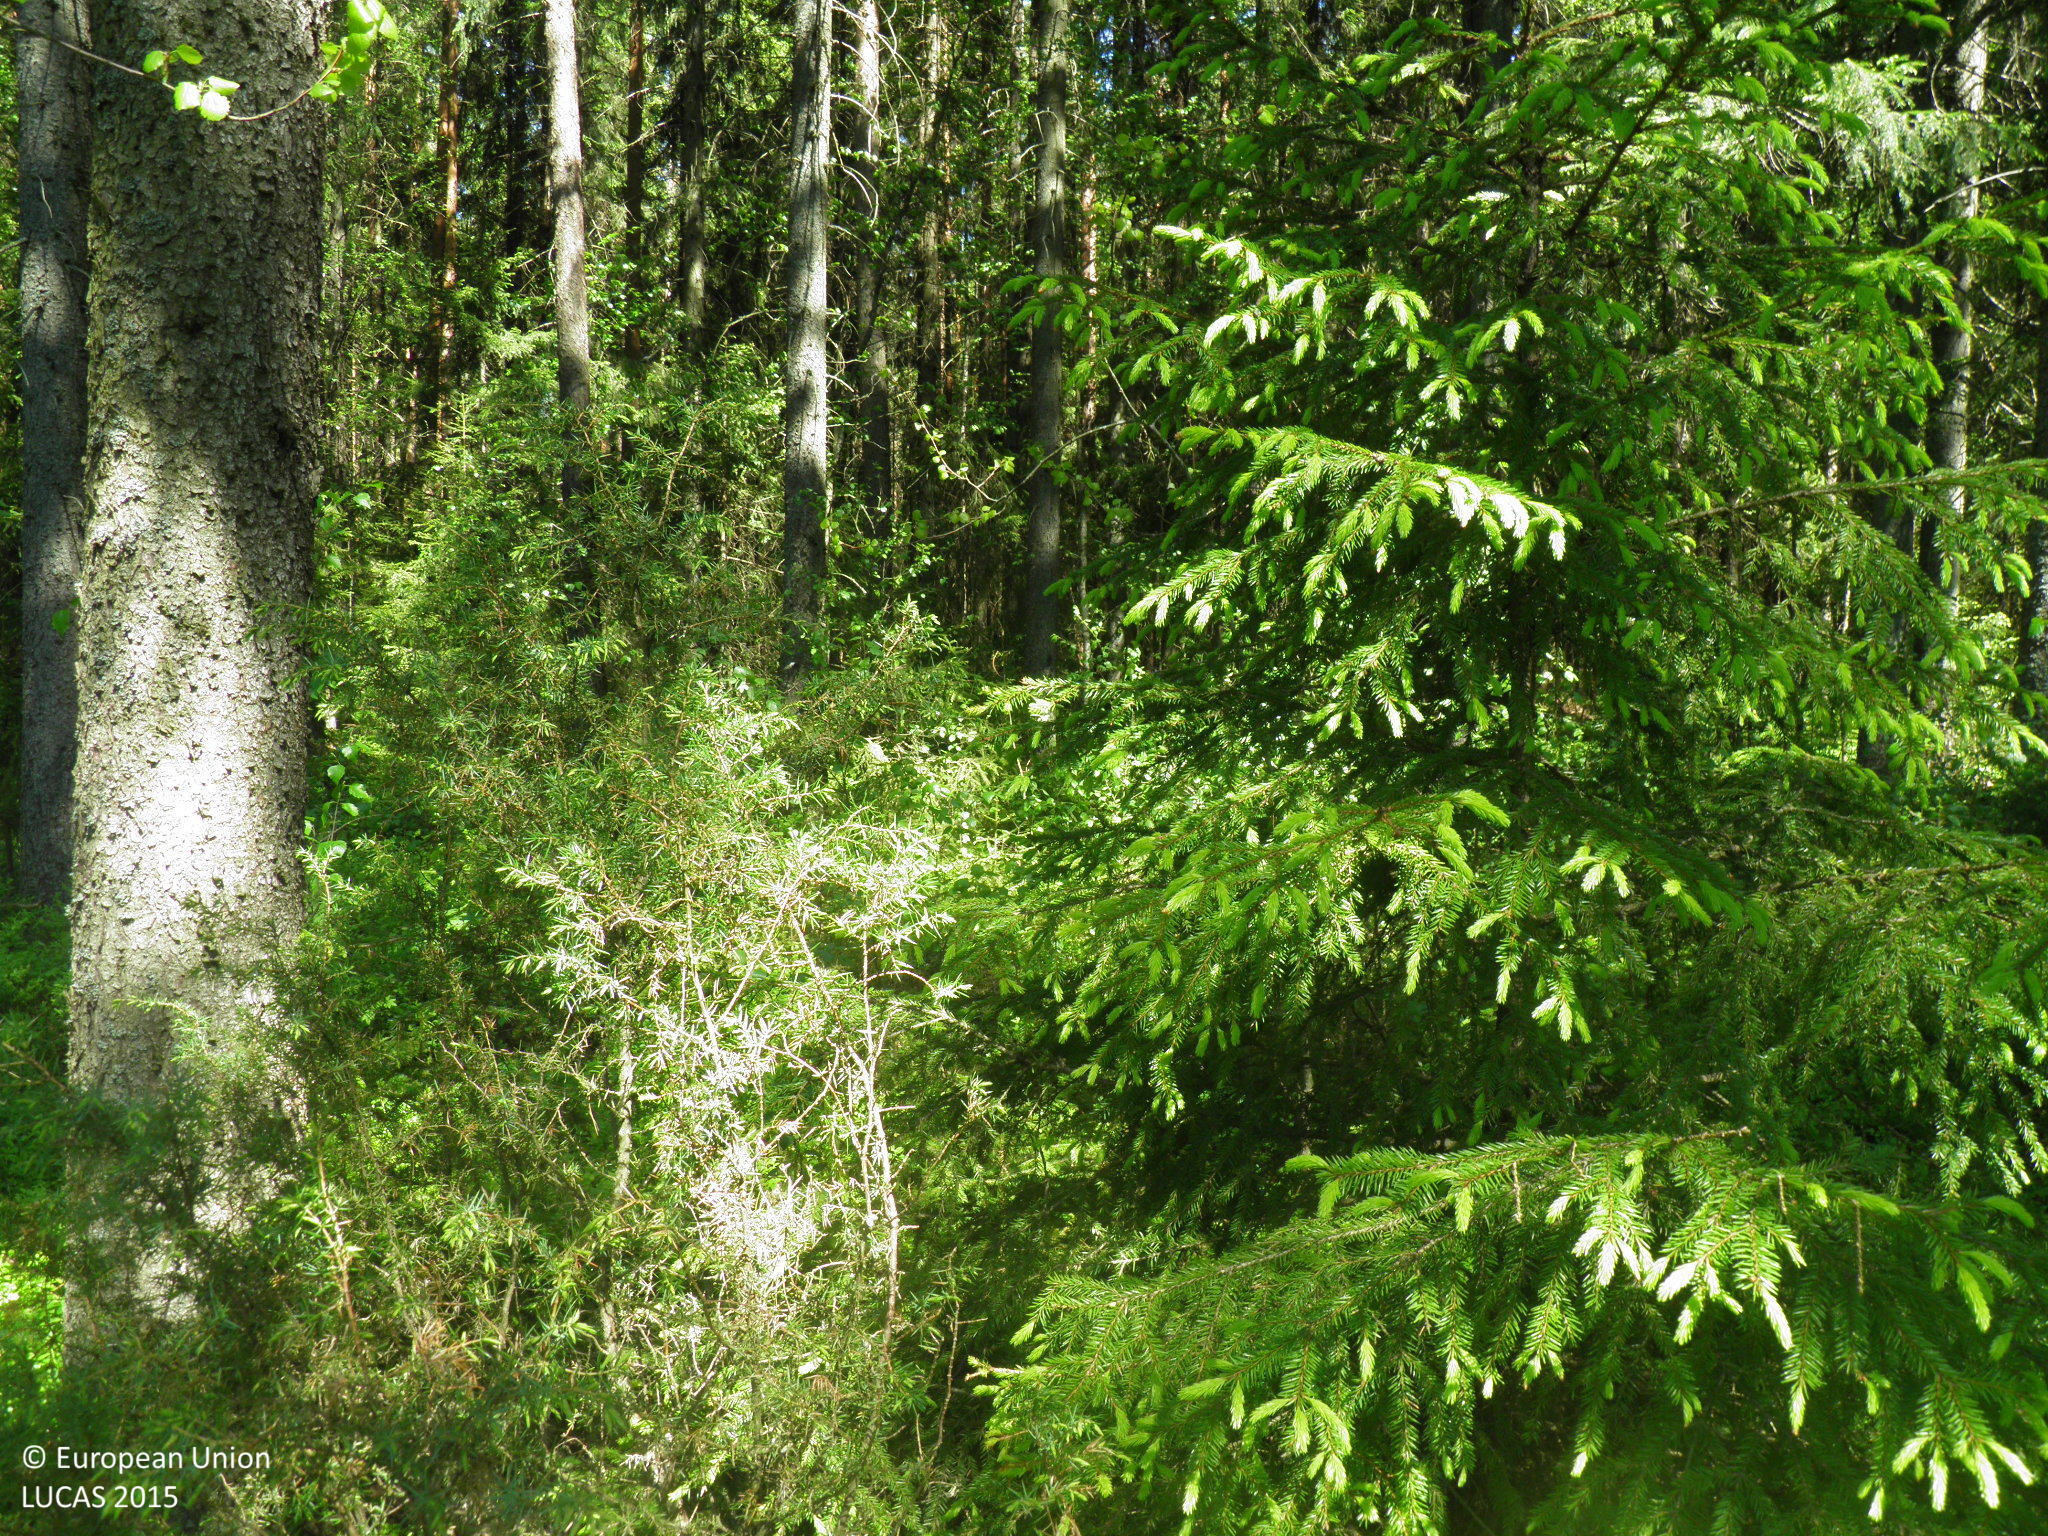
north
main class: Woodland
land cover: Spruce dominated coniferous woodland
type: boreal forest
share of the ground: > 75 %
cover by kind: coniferous forest trees 90 %, broadleaved forest trees 5 %, shrubs 5 %
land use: Forestry
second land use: Amenities, museums, leisure
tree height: > 5 m
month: June
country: FI
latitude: 60.6023
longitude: 22.3585
